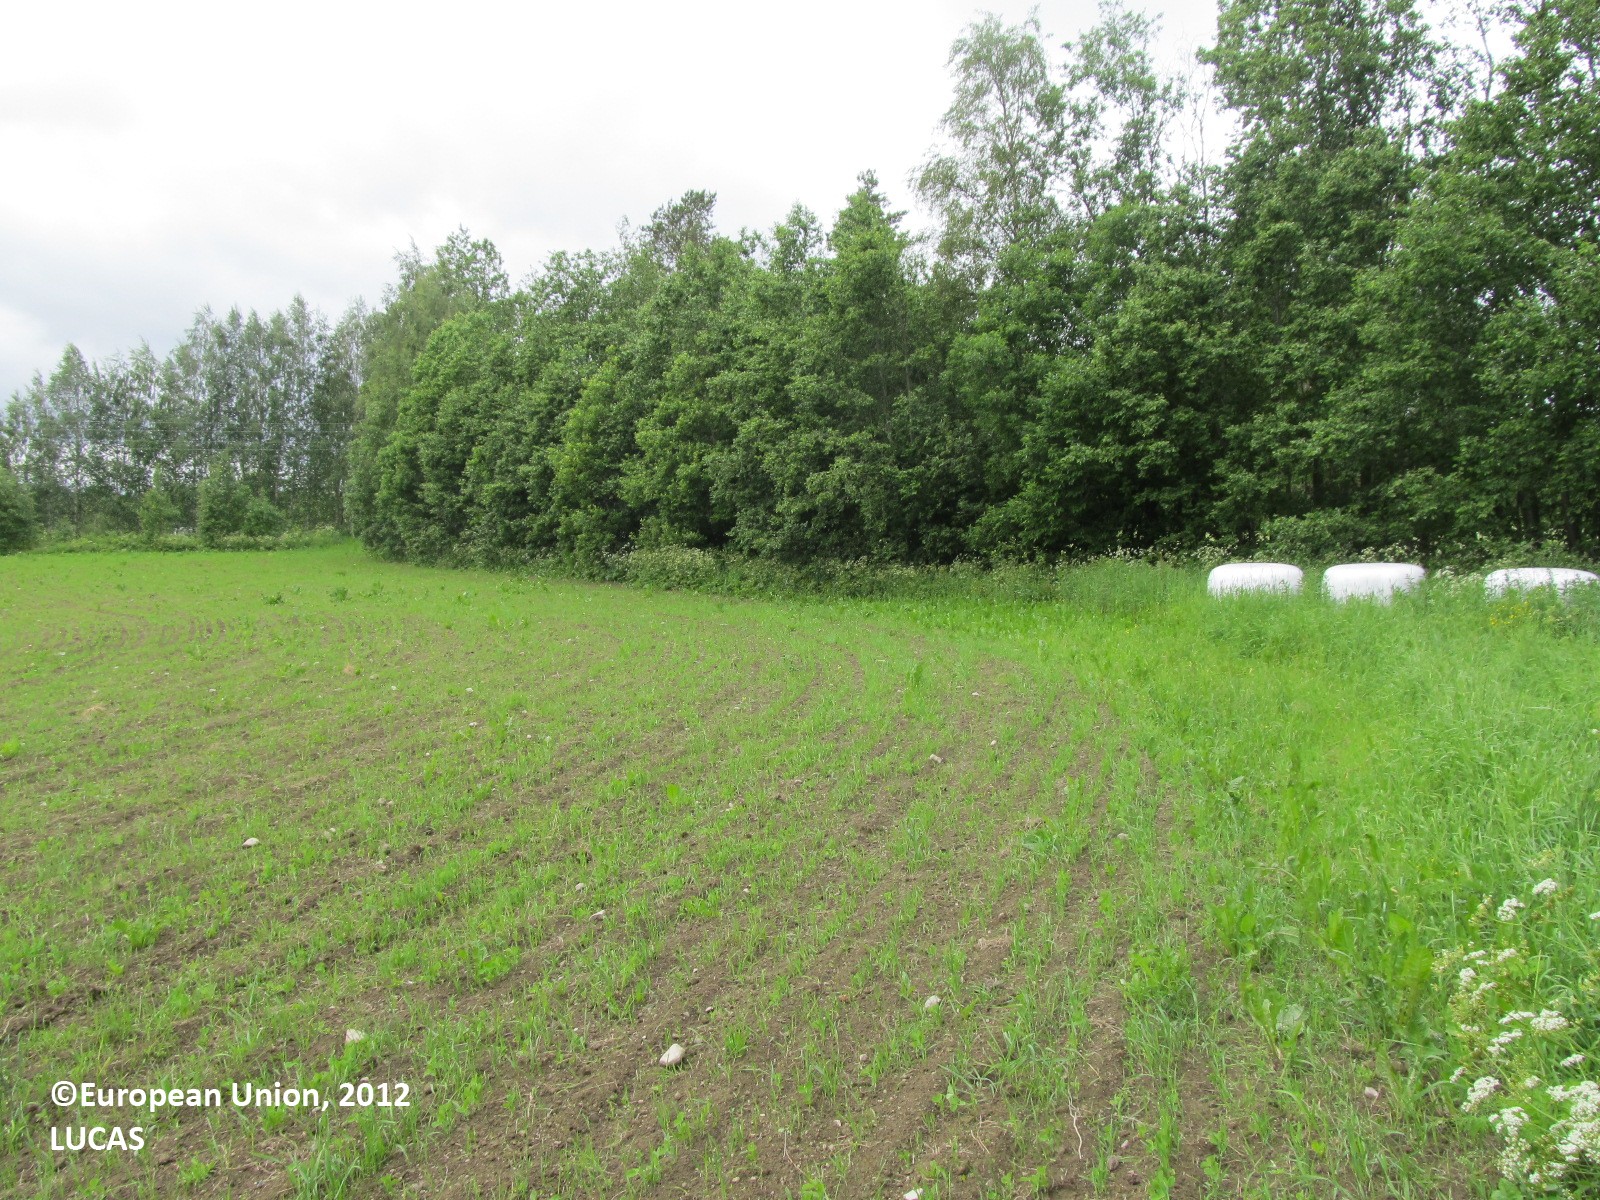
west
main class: Cropland
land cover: Oats
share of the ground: 10 - 25 %
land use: Agriculture (excluding fallow land and kitchen gardens)
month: June
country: FI
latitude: 62.7500
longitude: 29.1126
